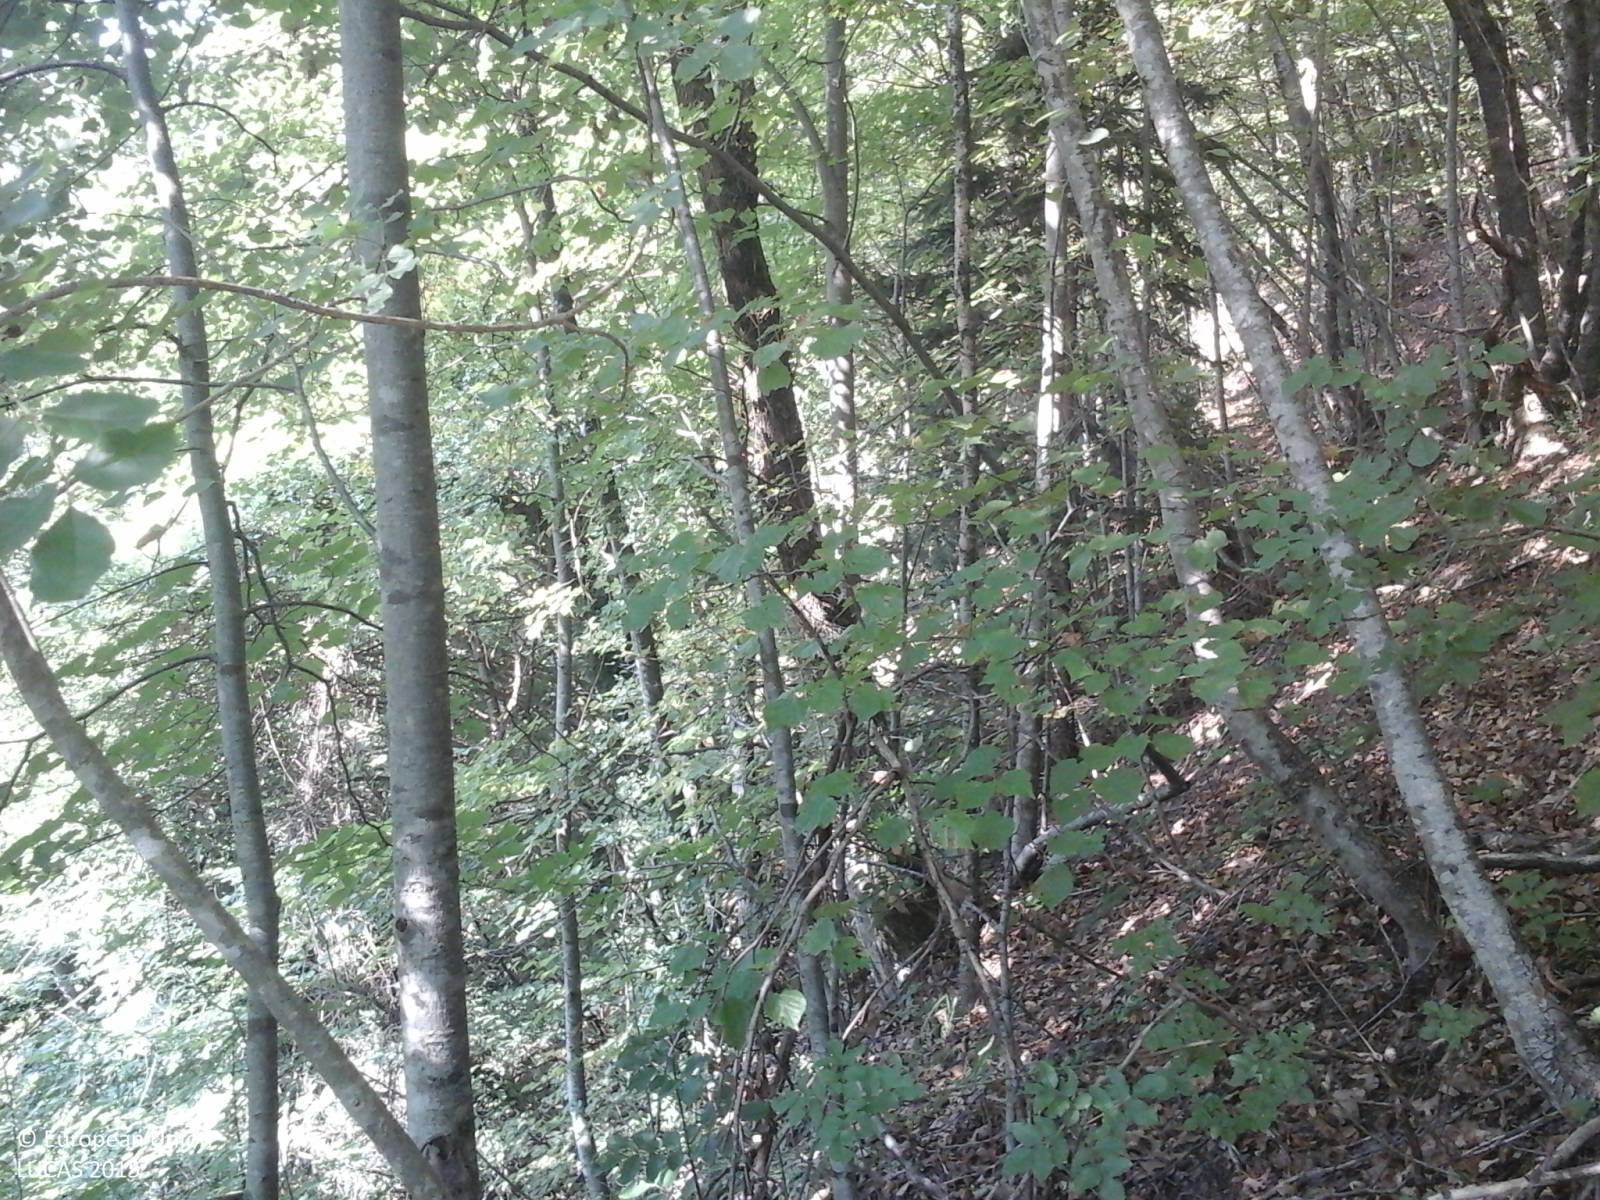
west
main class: Woodland
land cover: Broadleaved woodland
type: beech forest
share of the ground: > 75 %
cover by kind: broadleaved forest trees 80 %, coniferous forest trees 20 %
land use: Forestry
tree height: > 5 m
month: September
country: IT
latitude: 46.4697
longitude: 13.0574
